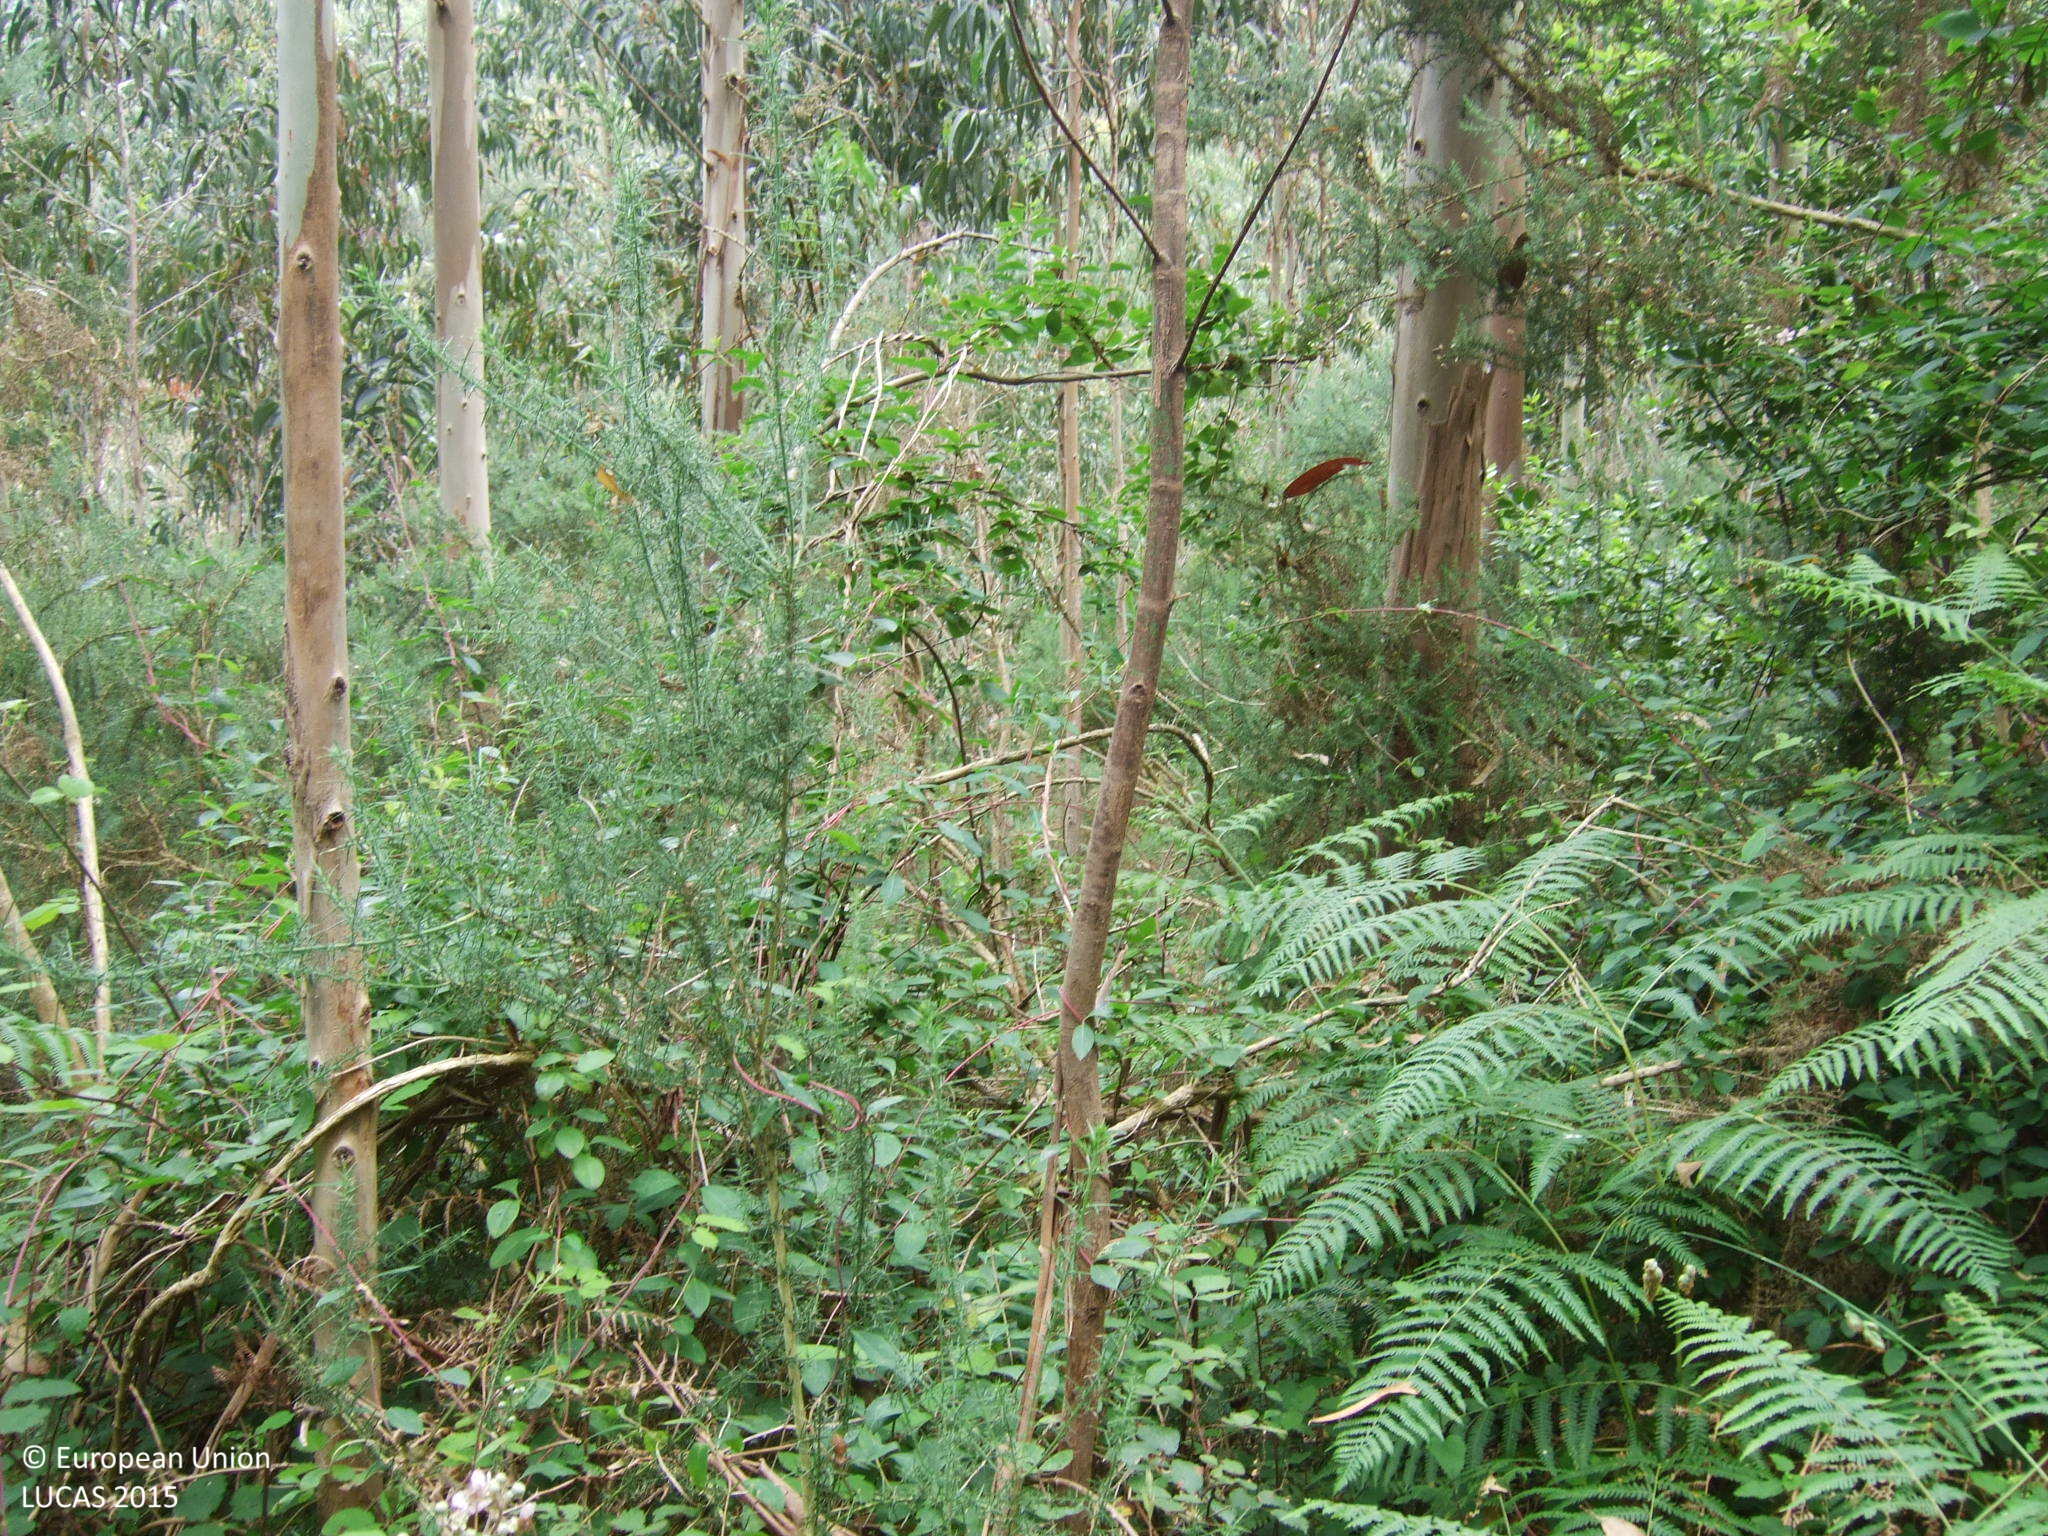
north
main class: Woodland
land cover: Broadleaved woodland
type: exotic forest
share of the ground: 50 - 75 %
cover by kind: broadleaved forest trees 65 %, shrubs 35 %
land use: Forestry
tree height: > 5 m
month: June
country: ES
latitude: 43.6463
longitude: -7.5783
